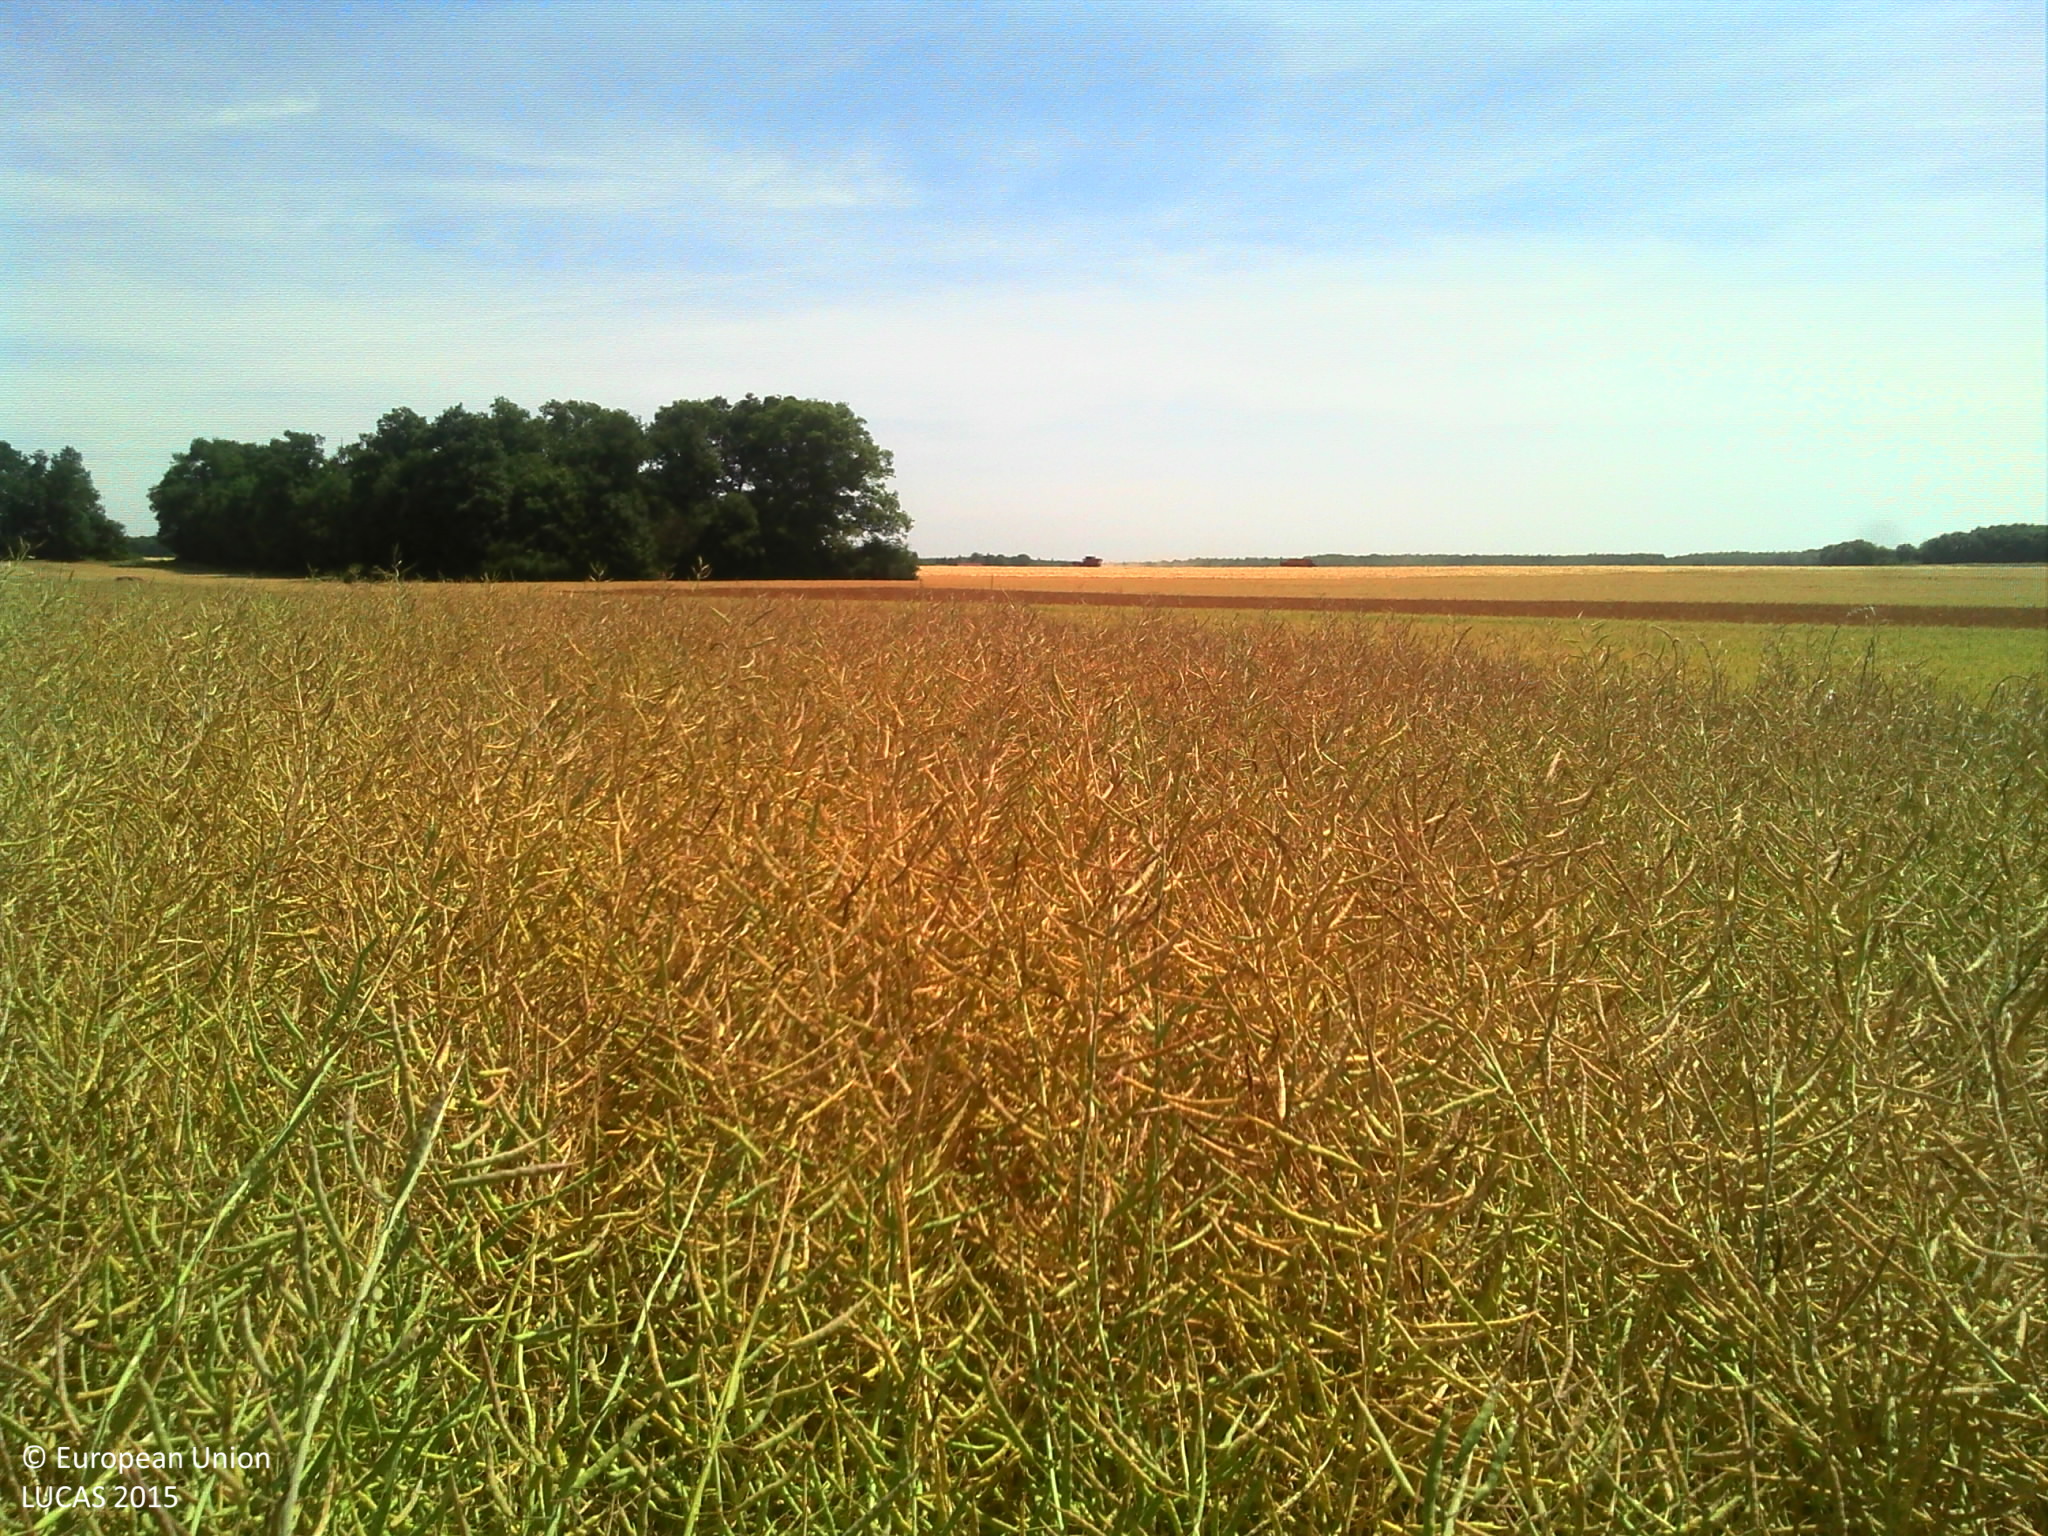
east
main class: Cropland
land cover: Rape and turnip rape
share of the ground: > 75 %
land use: Agriculture (excluding fallow land and kitchen gardens)
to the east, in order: Rape and turnip rape; Common wheat; Tracks; Barley
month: June
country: FR
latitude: 48.6313
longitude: 1.2017
